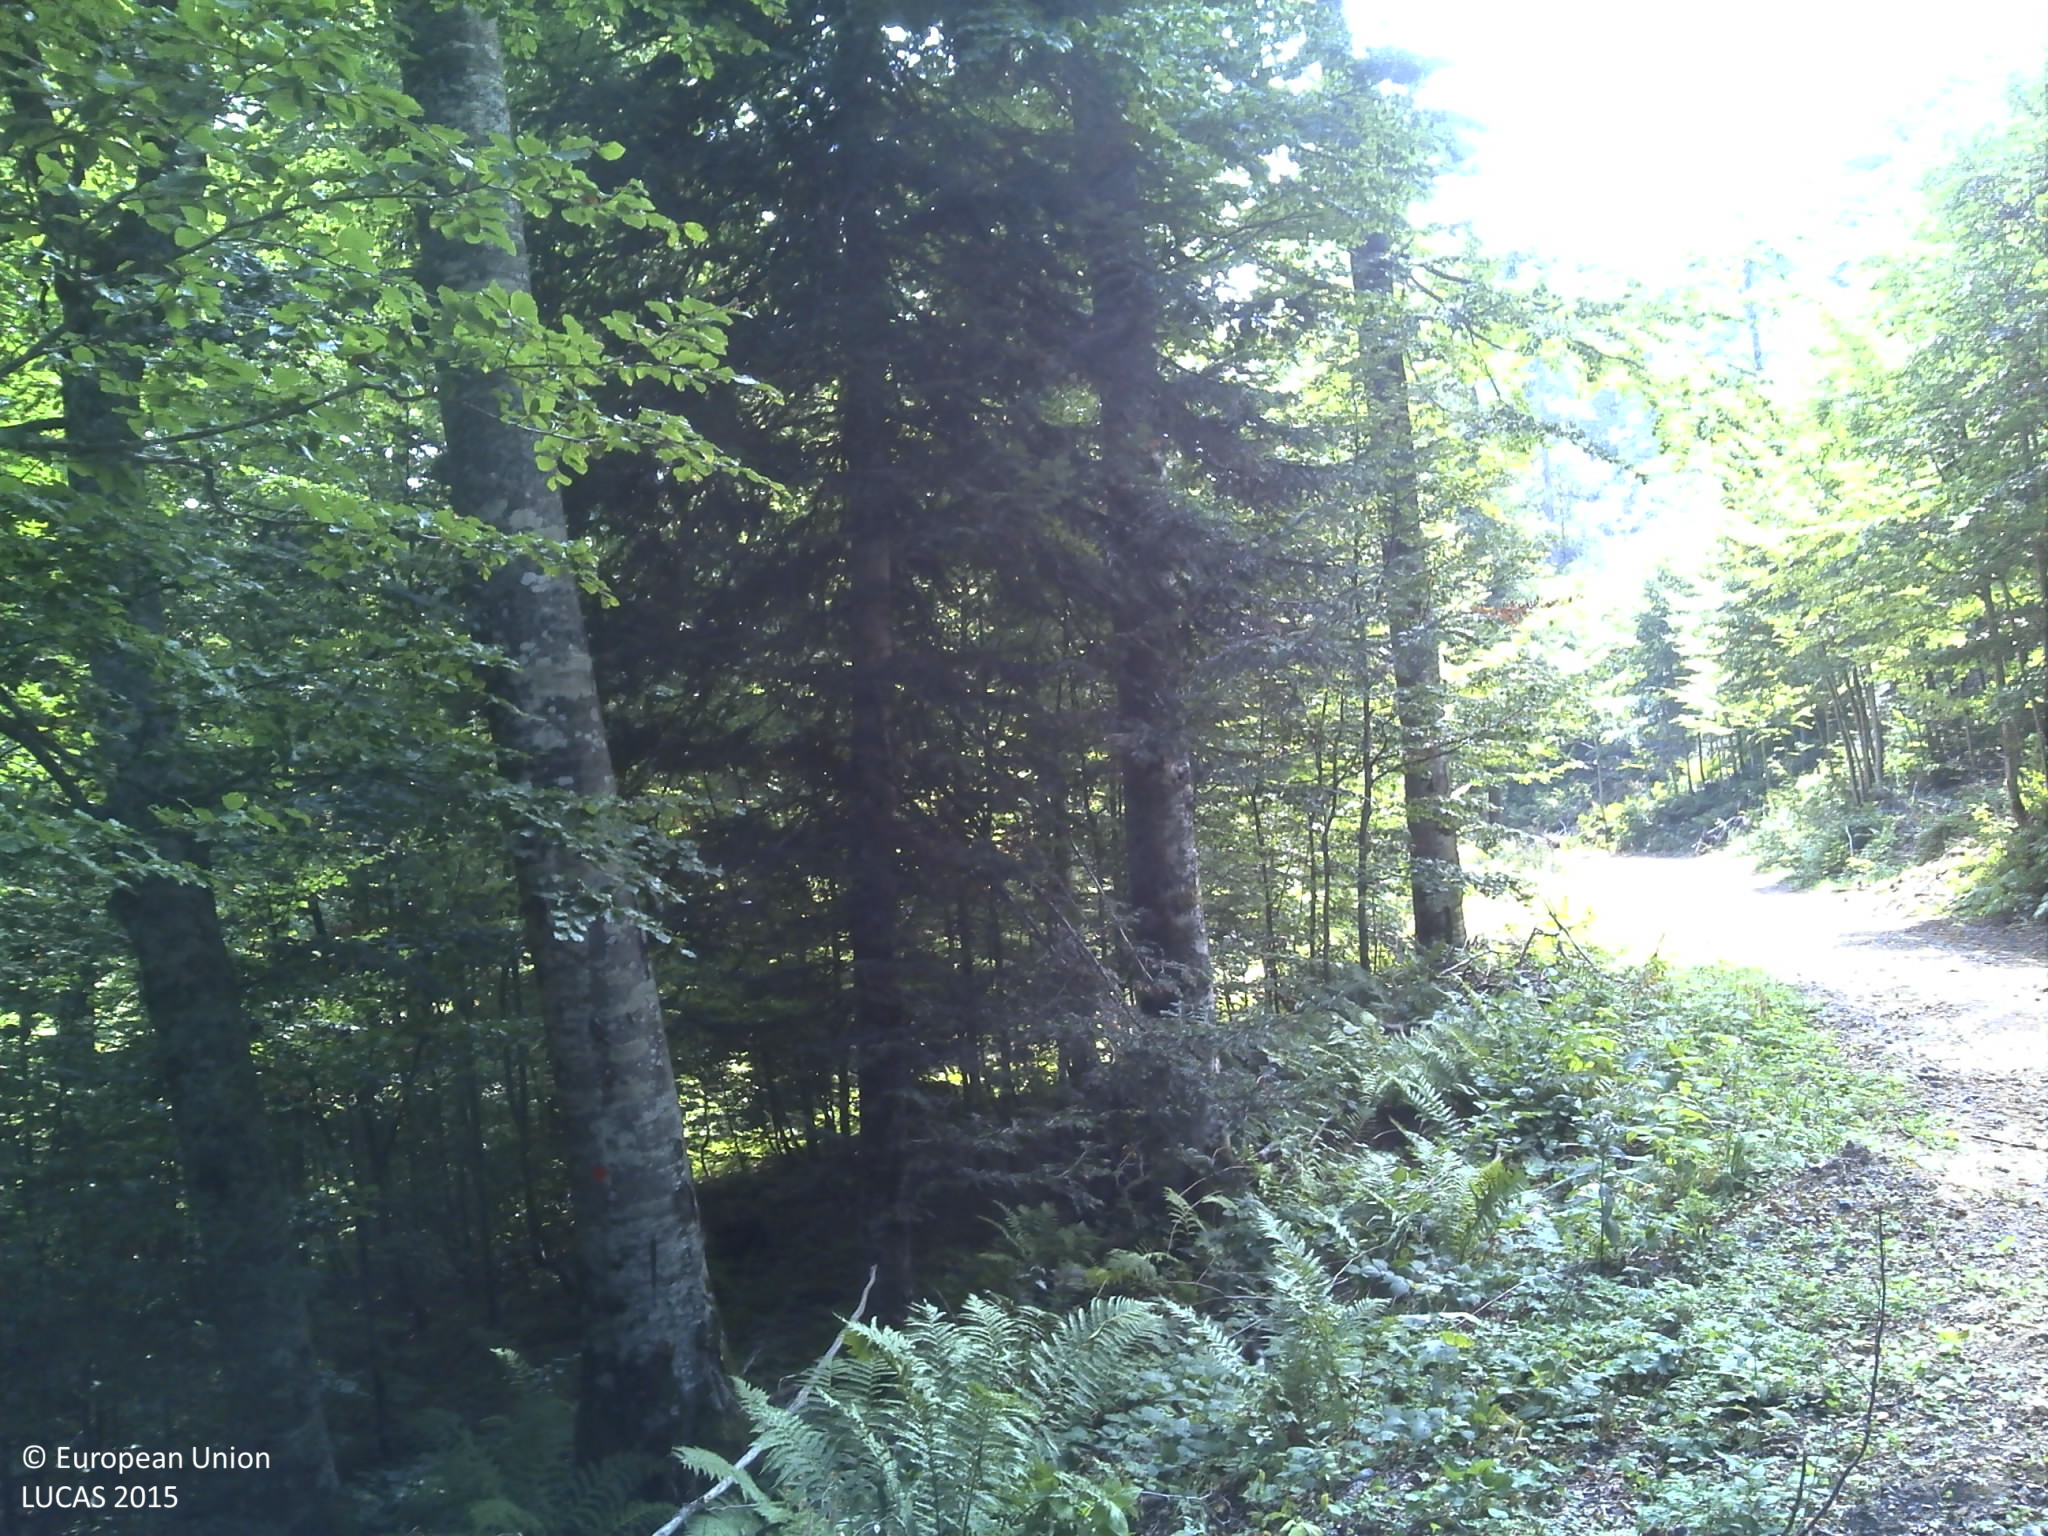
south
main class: Woodland
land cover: Broadleaved woodland
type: mountainous beech forest
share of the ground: > 75 %
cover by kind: broadleaved forest trees 95 %, coniferous forest trees 5 %
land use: Forestry
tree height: > 5 m
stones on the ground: < 10 %
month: September
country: HR
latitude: 44.4725
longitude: 15.8895
